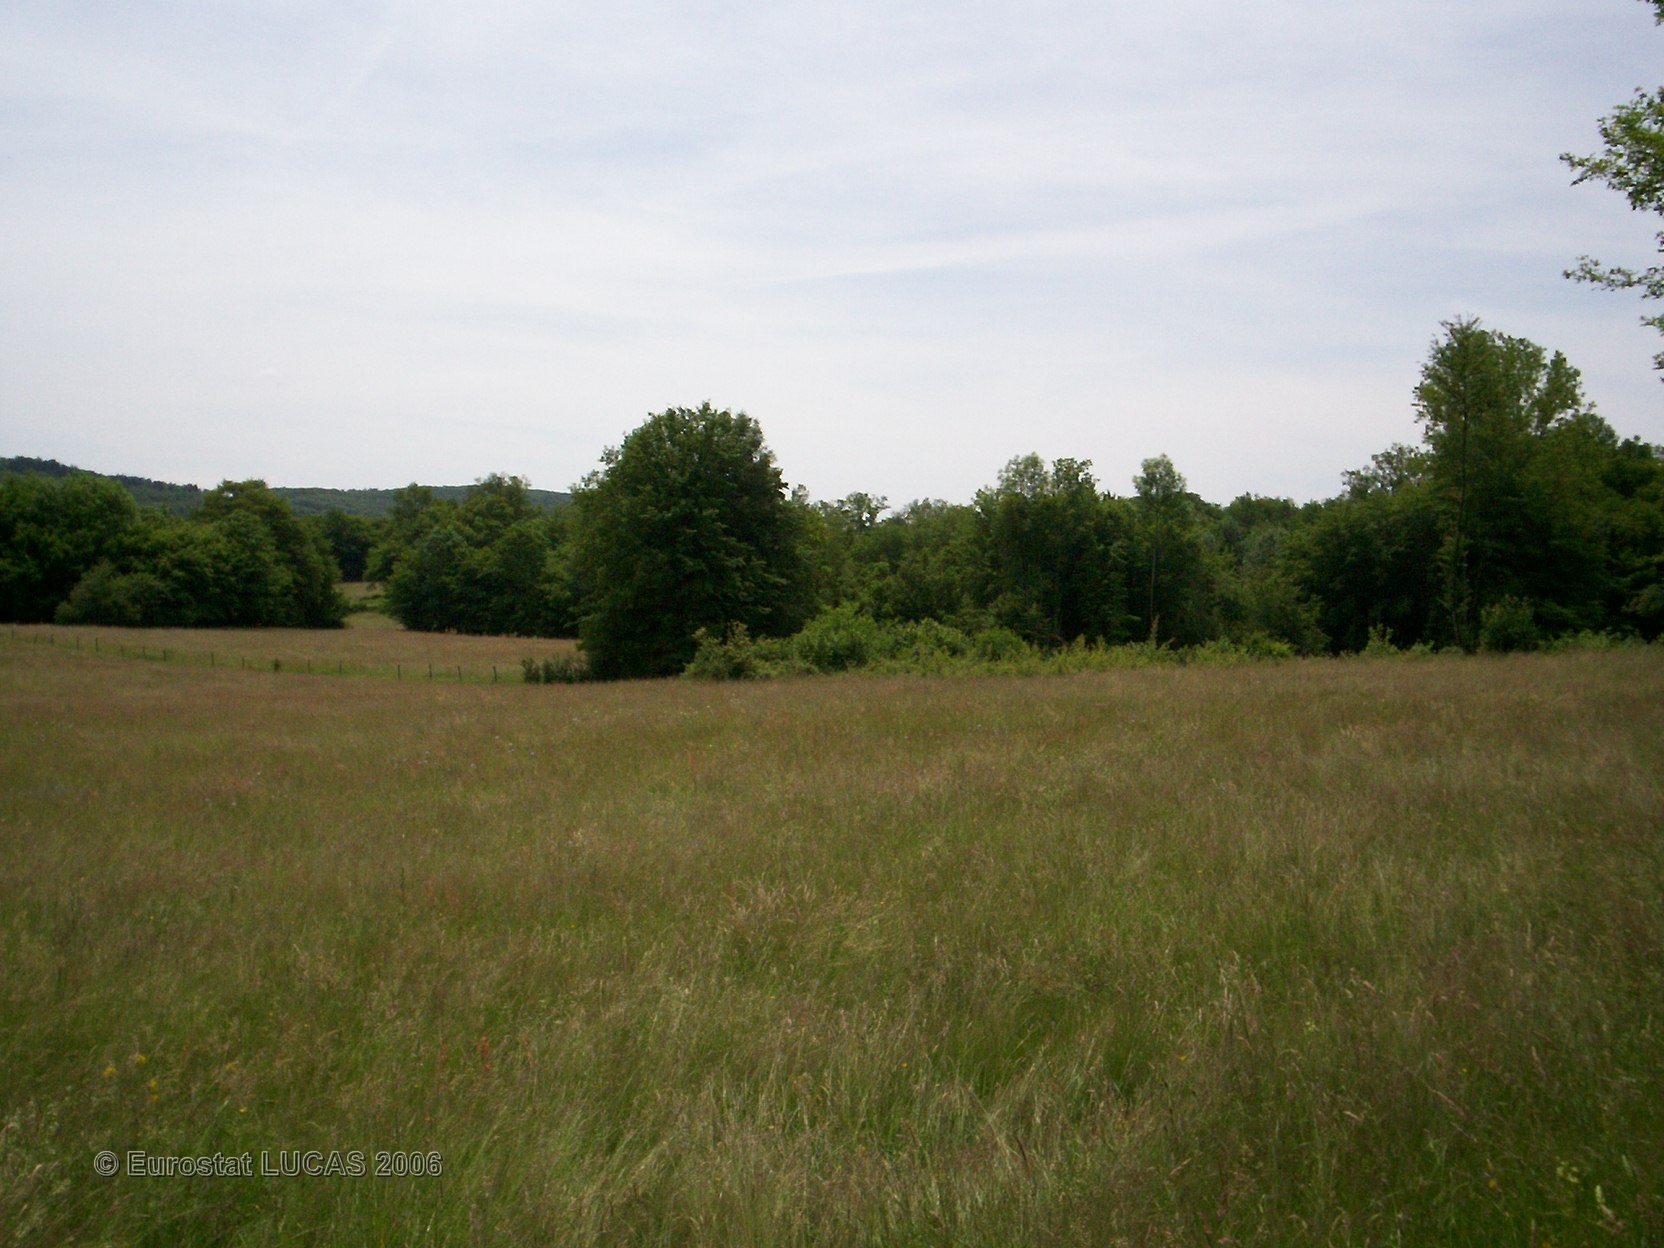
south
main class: Grassland
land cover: Grassland without tree/shrub cover
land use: Agriculture (excluding fallow land and kitchen gardens)
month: June
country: FR
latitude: 46.2331
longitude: 5.3738
